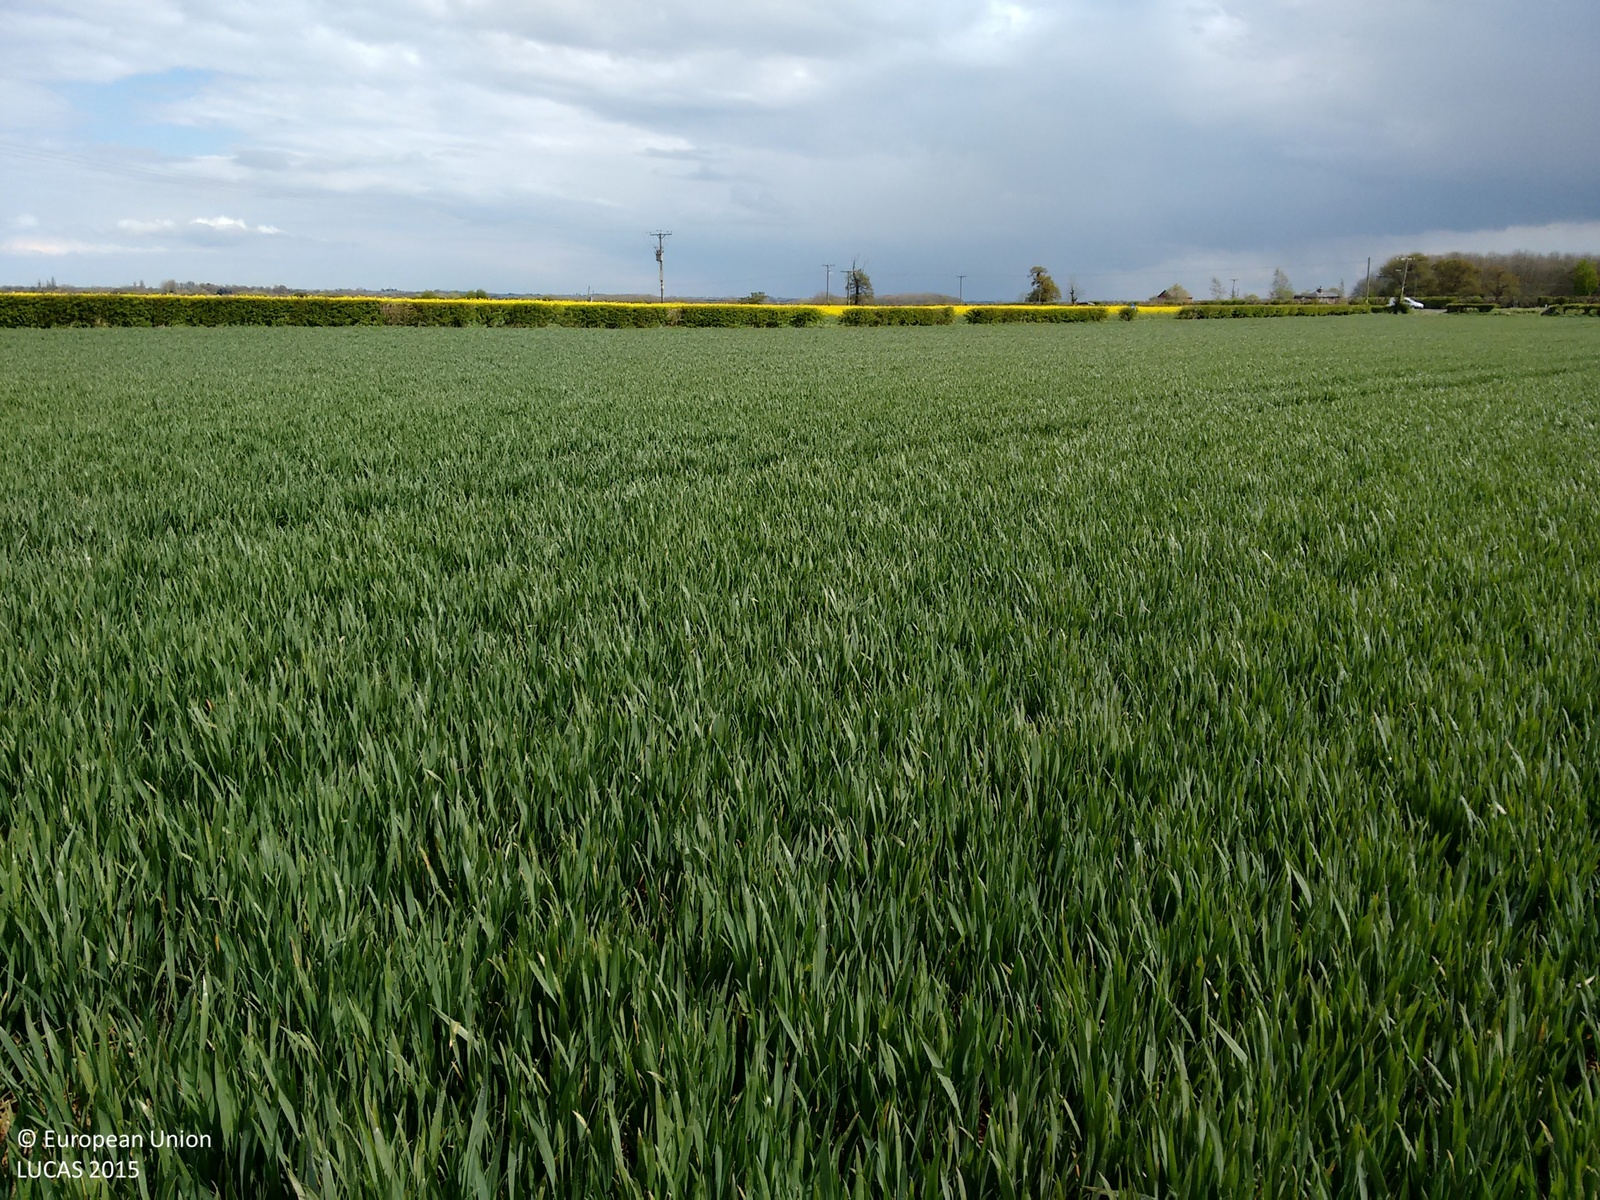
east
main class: Cropland
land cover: Barley
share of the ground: > 75 %
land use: Agriculture (excluding fallow land and kitchen gardens)
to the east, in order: Barley; Grass margins; Managed hedges; Ditches and canals; Grass margins; Rape and turnip rape; Electric lines; Rape and turnip rape
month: April
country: GB
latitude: 53.2533
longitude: 0.1521
